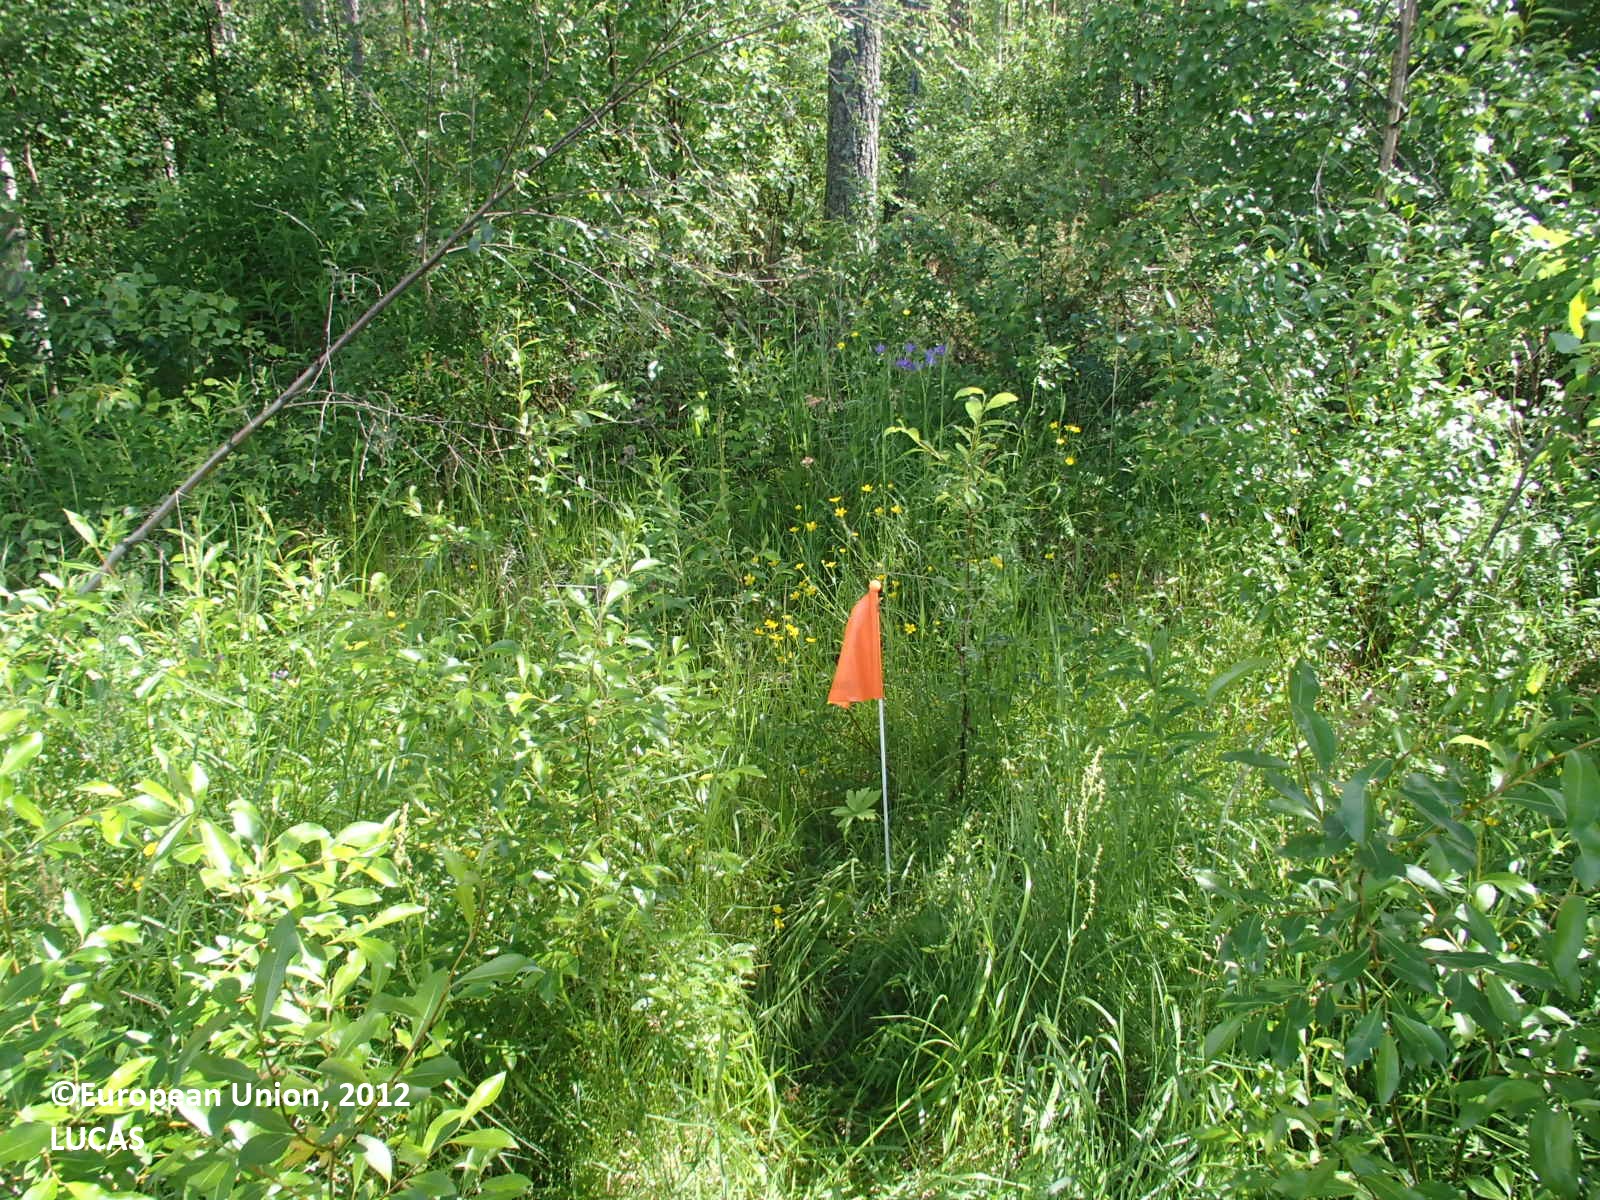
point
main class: Woodland
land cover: Pine dominated mixed woodland
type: boreal forest
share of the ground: > 75 %
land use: Forestry
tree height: > 5 m
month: July
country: FI
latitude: 64.2168
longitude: 26.9657
